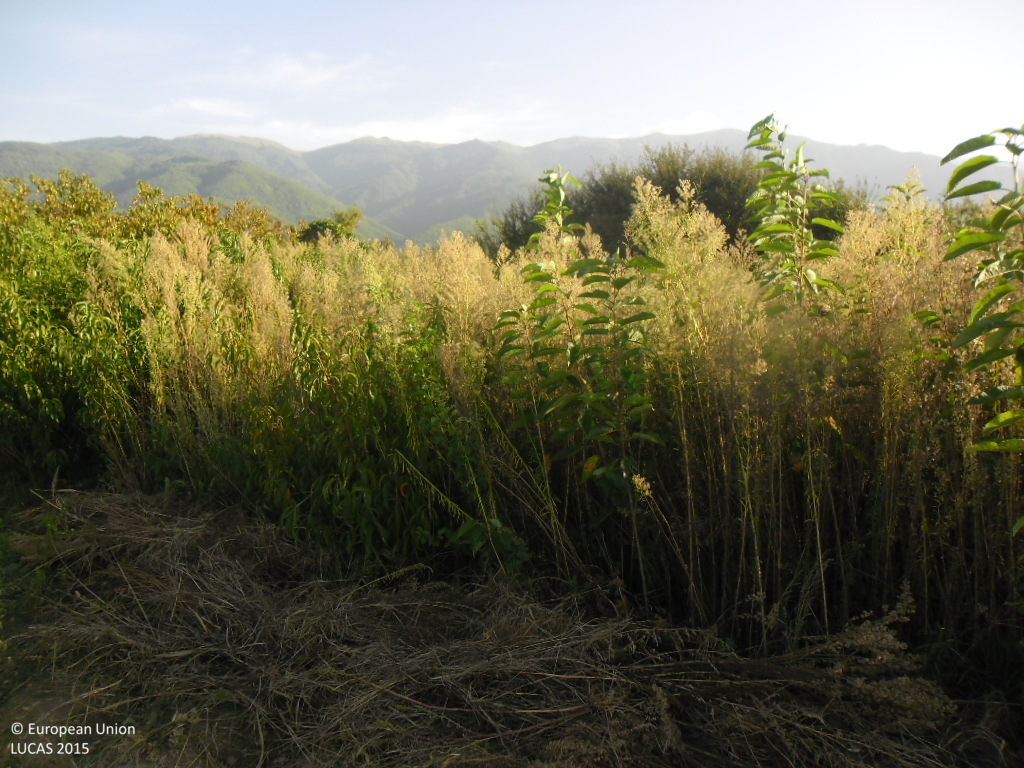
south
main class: Cropland
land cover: Pear fruit
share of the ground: > 75 %
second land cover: Grassland without tree/shrub cover
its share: 10 - 25 %
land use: Agriculture (excluding fallow land and kitchen gardens)
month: September
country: BG
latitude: 41.3920
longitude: 23.1378
